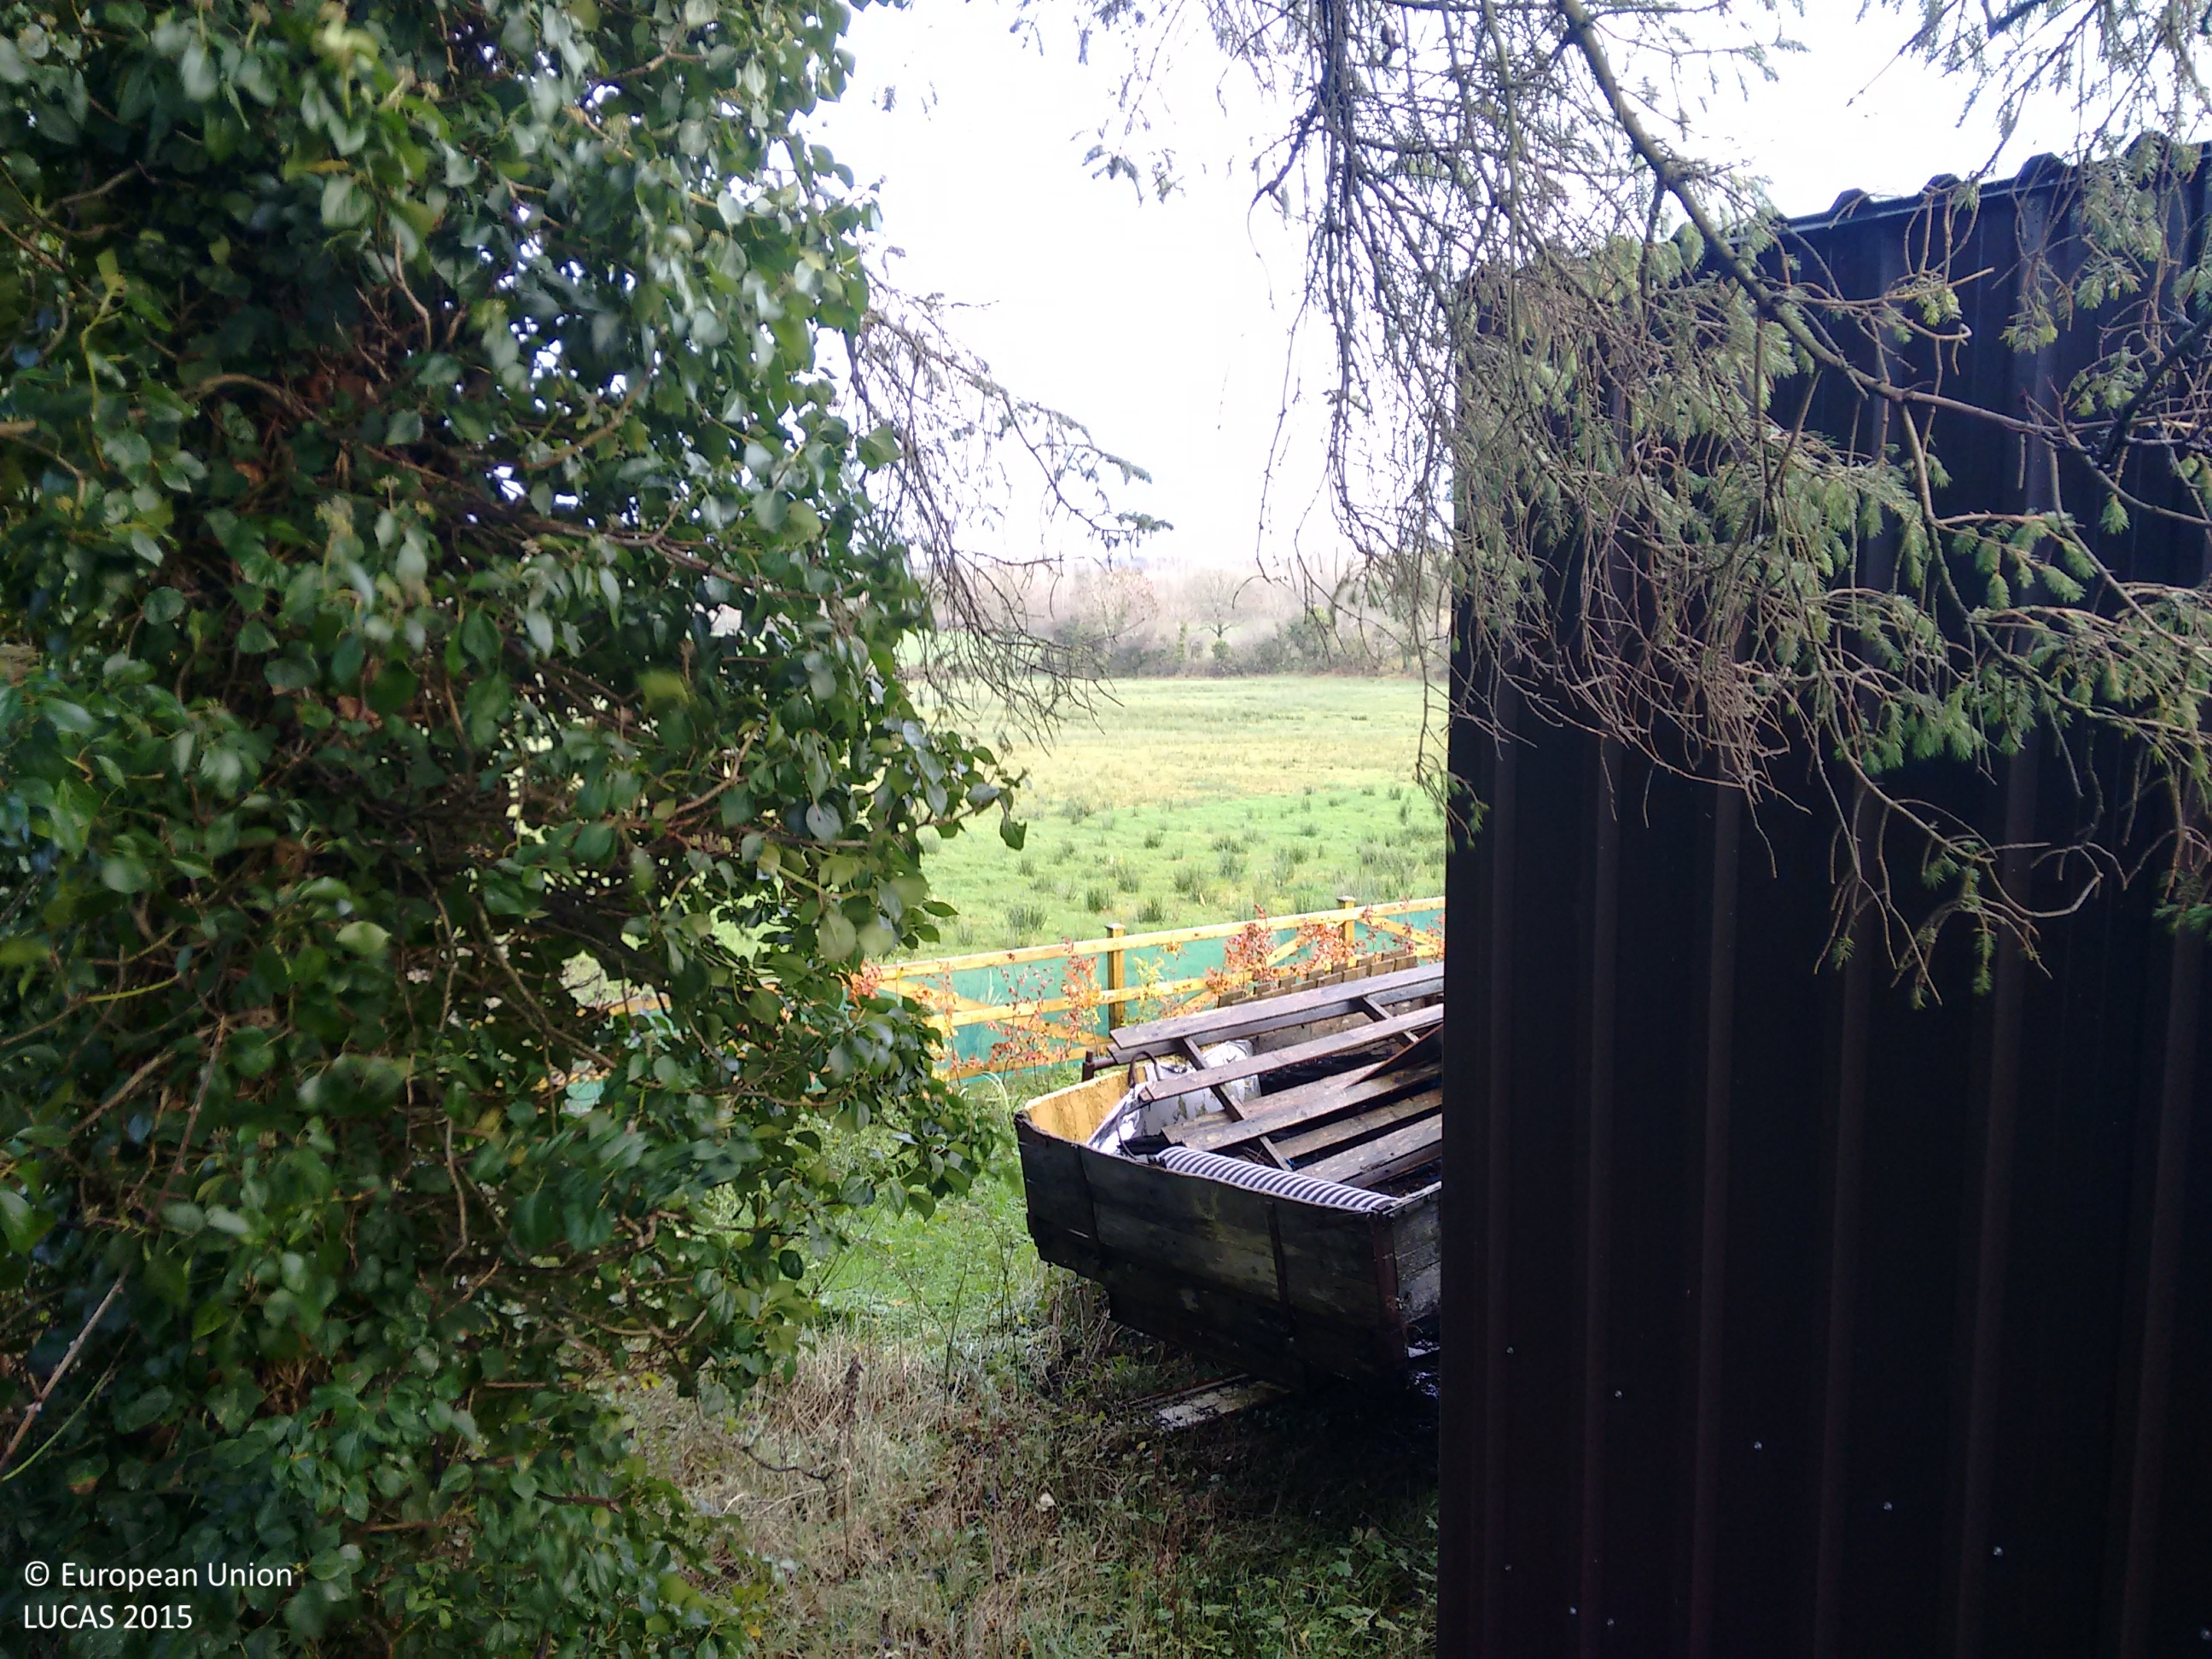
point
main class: Grassland
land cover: Grassland without tree/shrub cover
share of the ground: > 75 %
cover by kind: herbaceous plants 100 %
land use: Agriculture (excluding fallow land and kitchen gardens)
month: November
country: IE
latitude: 53.9055
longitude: -7.9668
